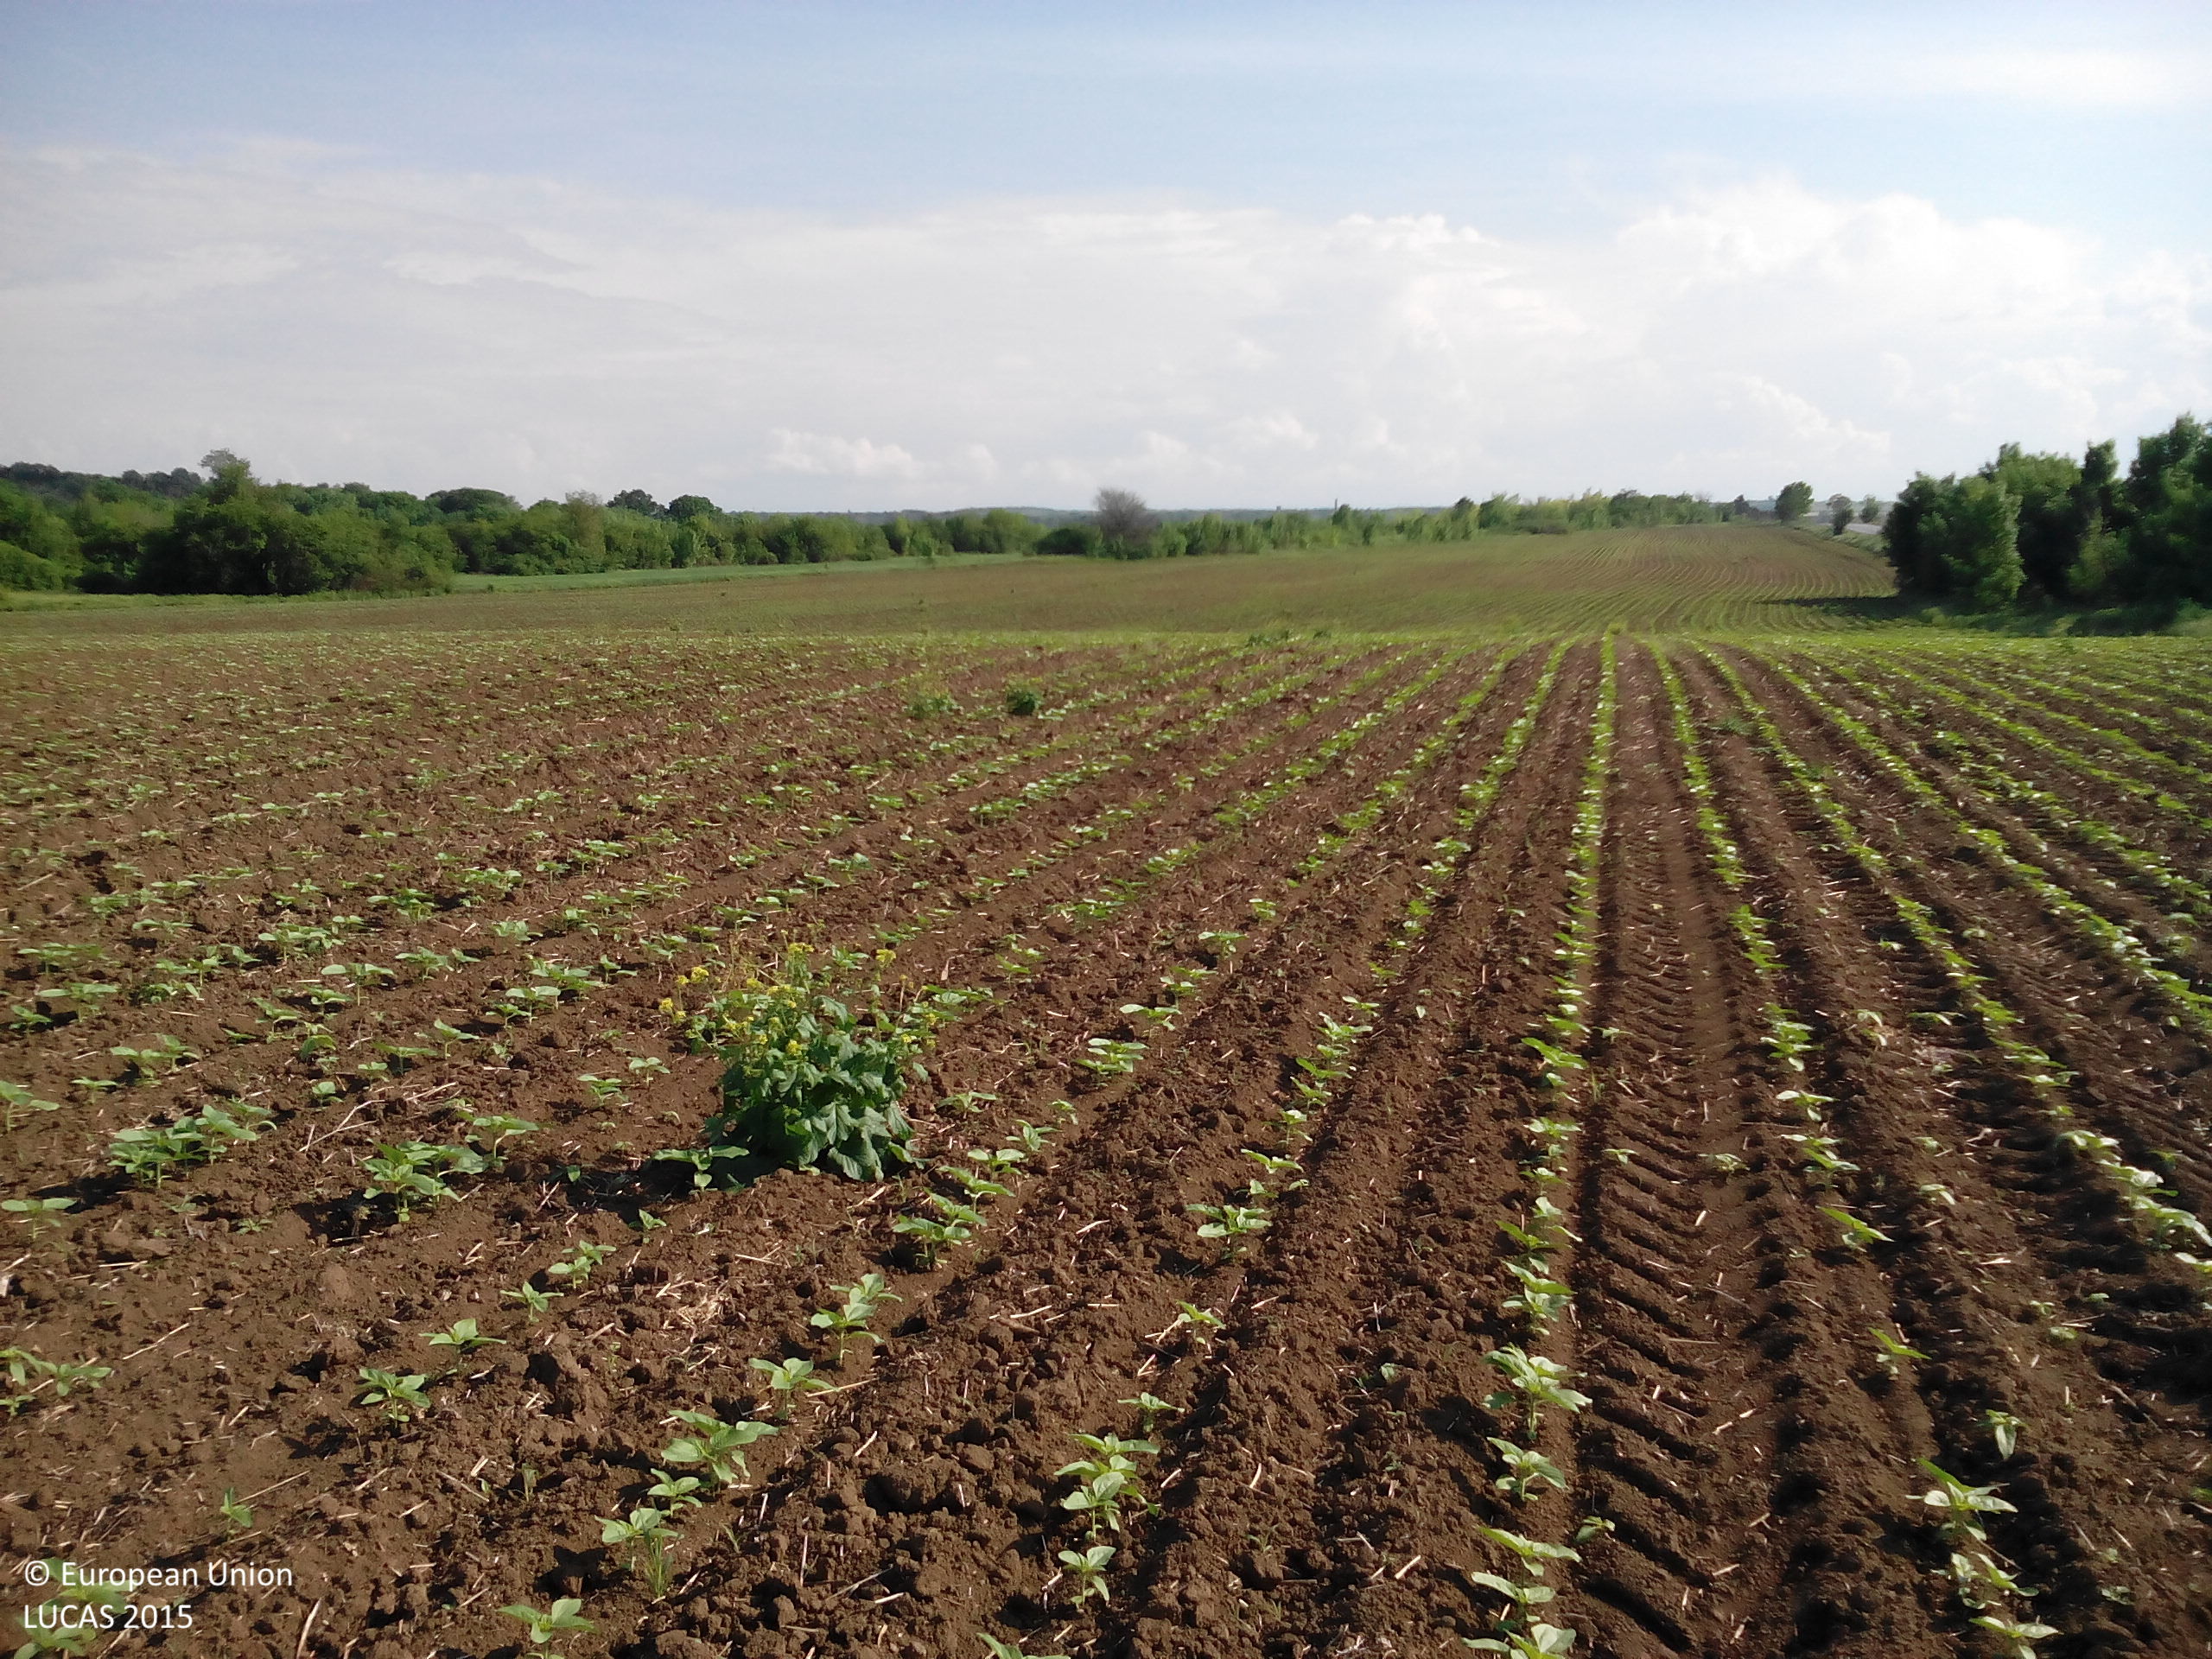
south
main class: Cropland
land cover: Sunflower
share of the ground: 10 - 25 %
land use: Agriculture (excluding fallow land and kitchen gardens)
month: May
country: BG
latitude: 43.5511
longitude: 23.8018
